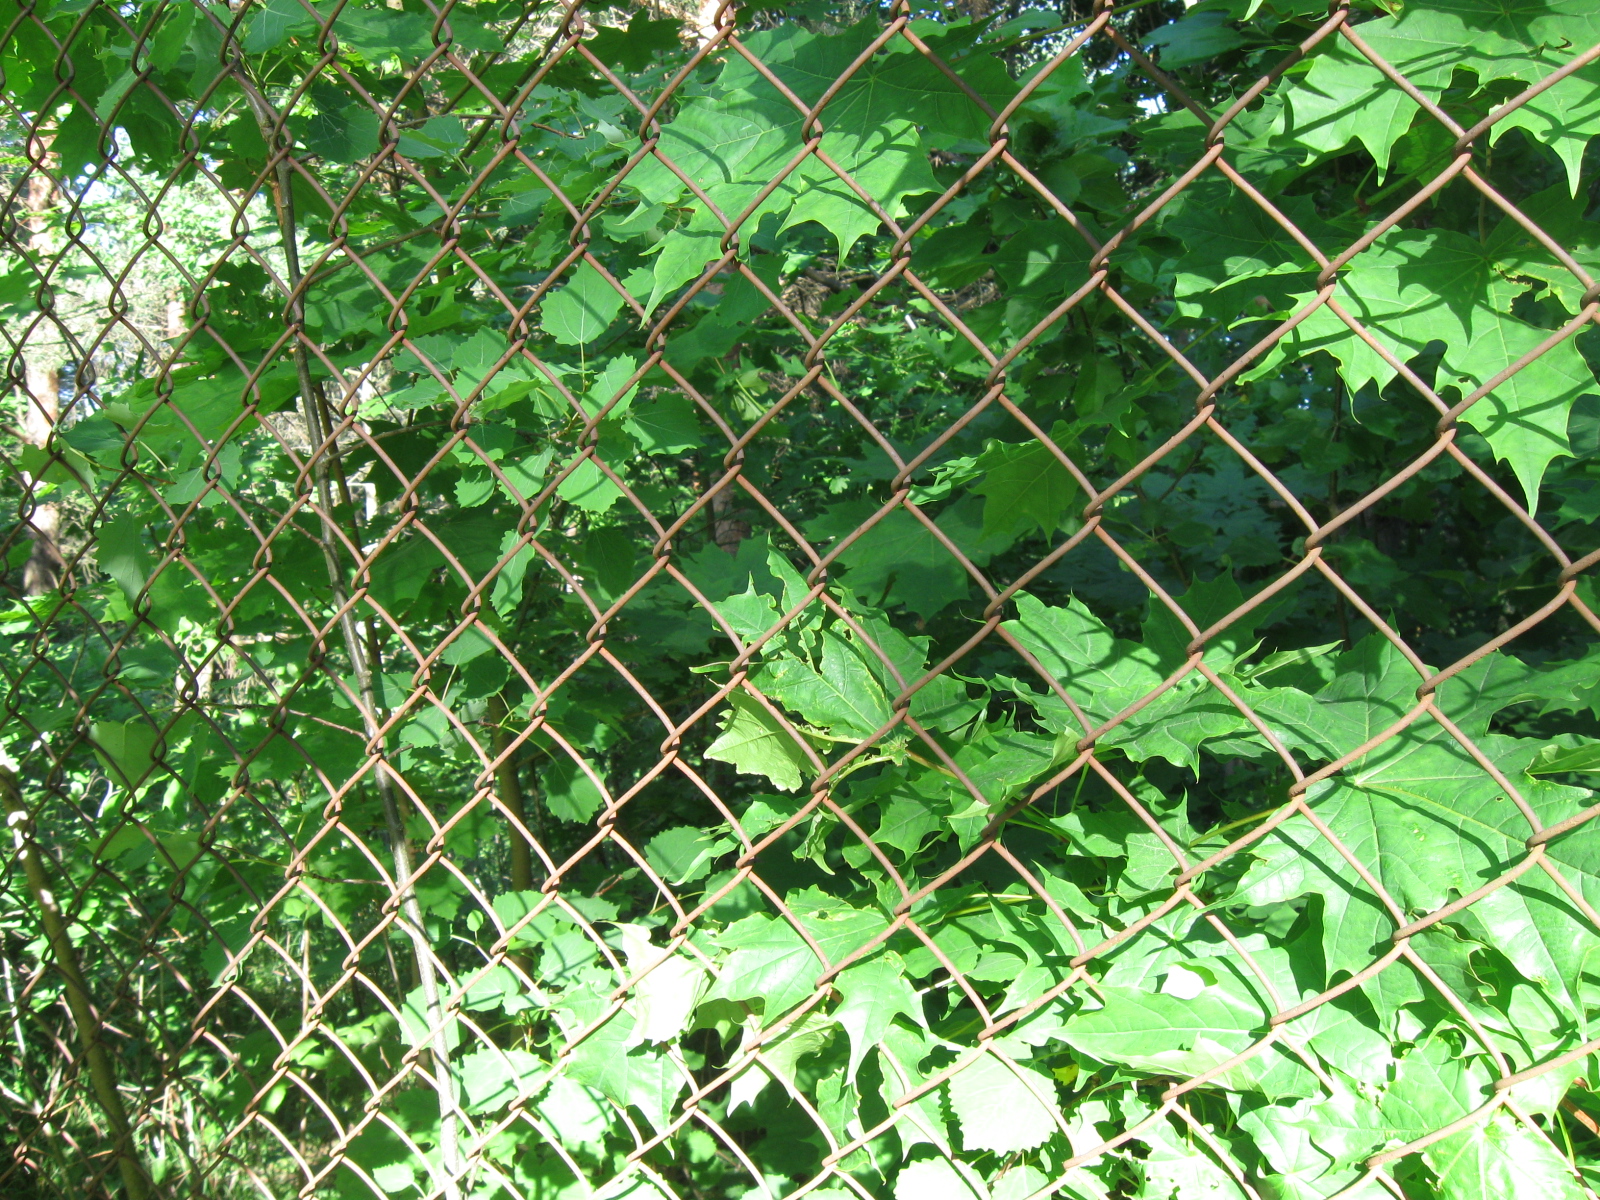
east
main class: Woodland
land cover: Pine dominated mixed woodland
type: hemiboreal forest and nemoral coniferous forest and mixed broadleaved-coniferous forest
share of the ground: > 75 %
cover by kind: broadleaved forest trees 60 %, coniferous forest trees 40 %
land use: Community services
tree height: > 5 m
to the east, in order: Pine dominated mixed woodland; Tracks; Broadleaved woodland; Grassland without tree/shrub cover; Single bushes/trees; Grassland without tree/shrub cover; Single bushes/trees; Grassland without tree/shrub cover; Other mixed woodland; Grassland without tree/shrub cover
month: June
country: LT
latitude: 54.8871
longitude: 23.9807
